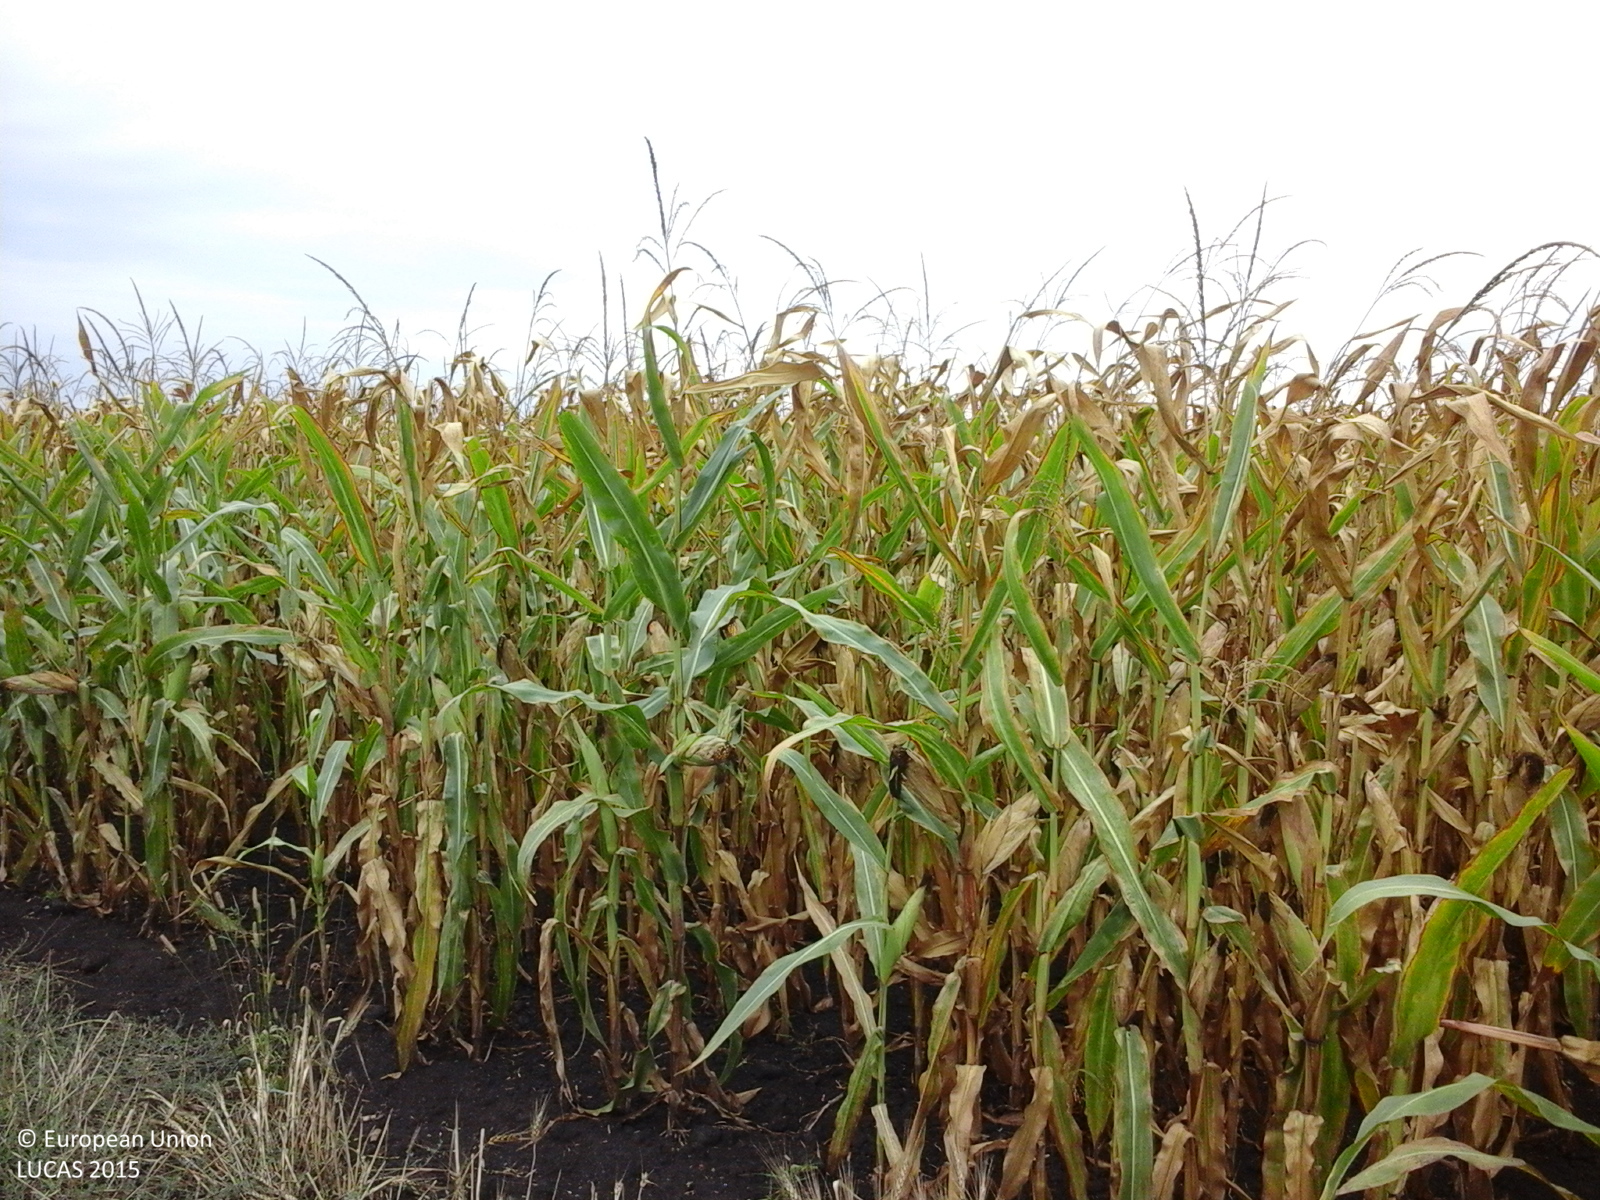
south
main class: Cropland
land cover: Maize
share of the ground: > 75 %
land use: Agriculture (excluding fallow land and kitchen gardens)
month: August
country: RO
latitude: 45.8236
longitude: 20.7738
